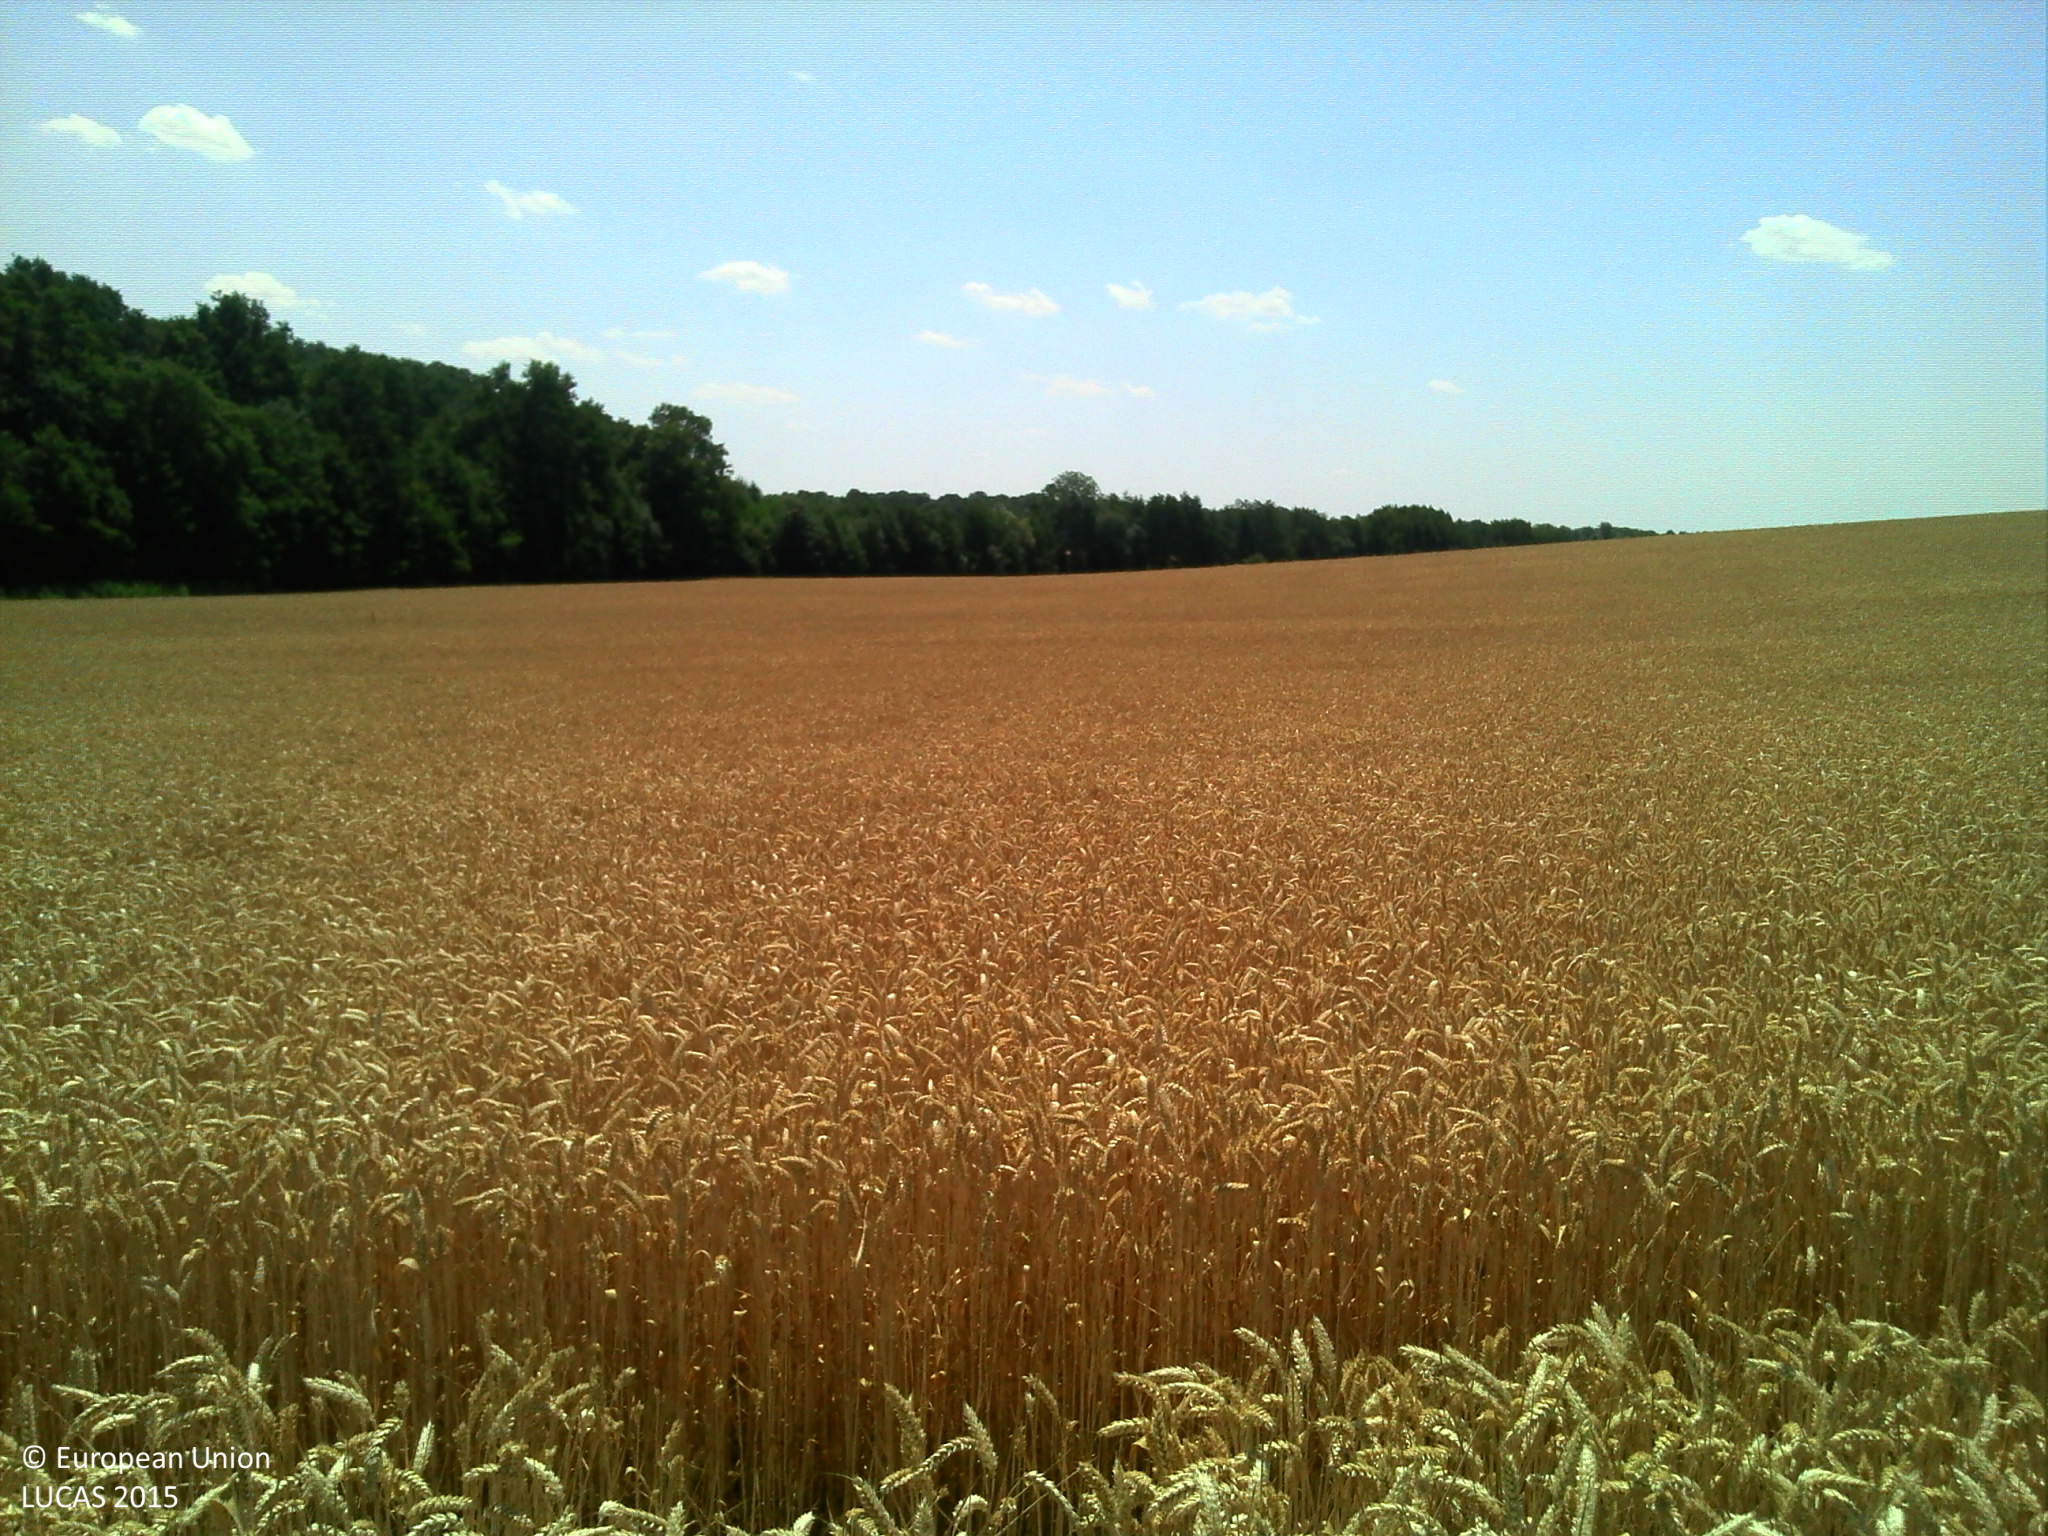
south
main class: Cropland
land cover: Common wheat
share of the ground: > 75 %
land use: Agriculture (excluding fallow land and kitchen gardens)
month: July
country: FR
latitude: 49.0166
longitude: 5.1167
